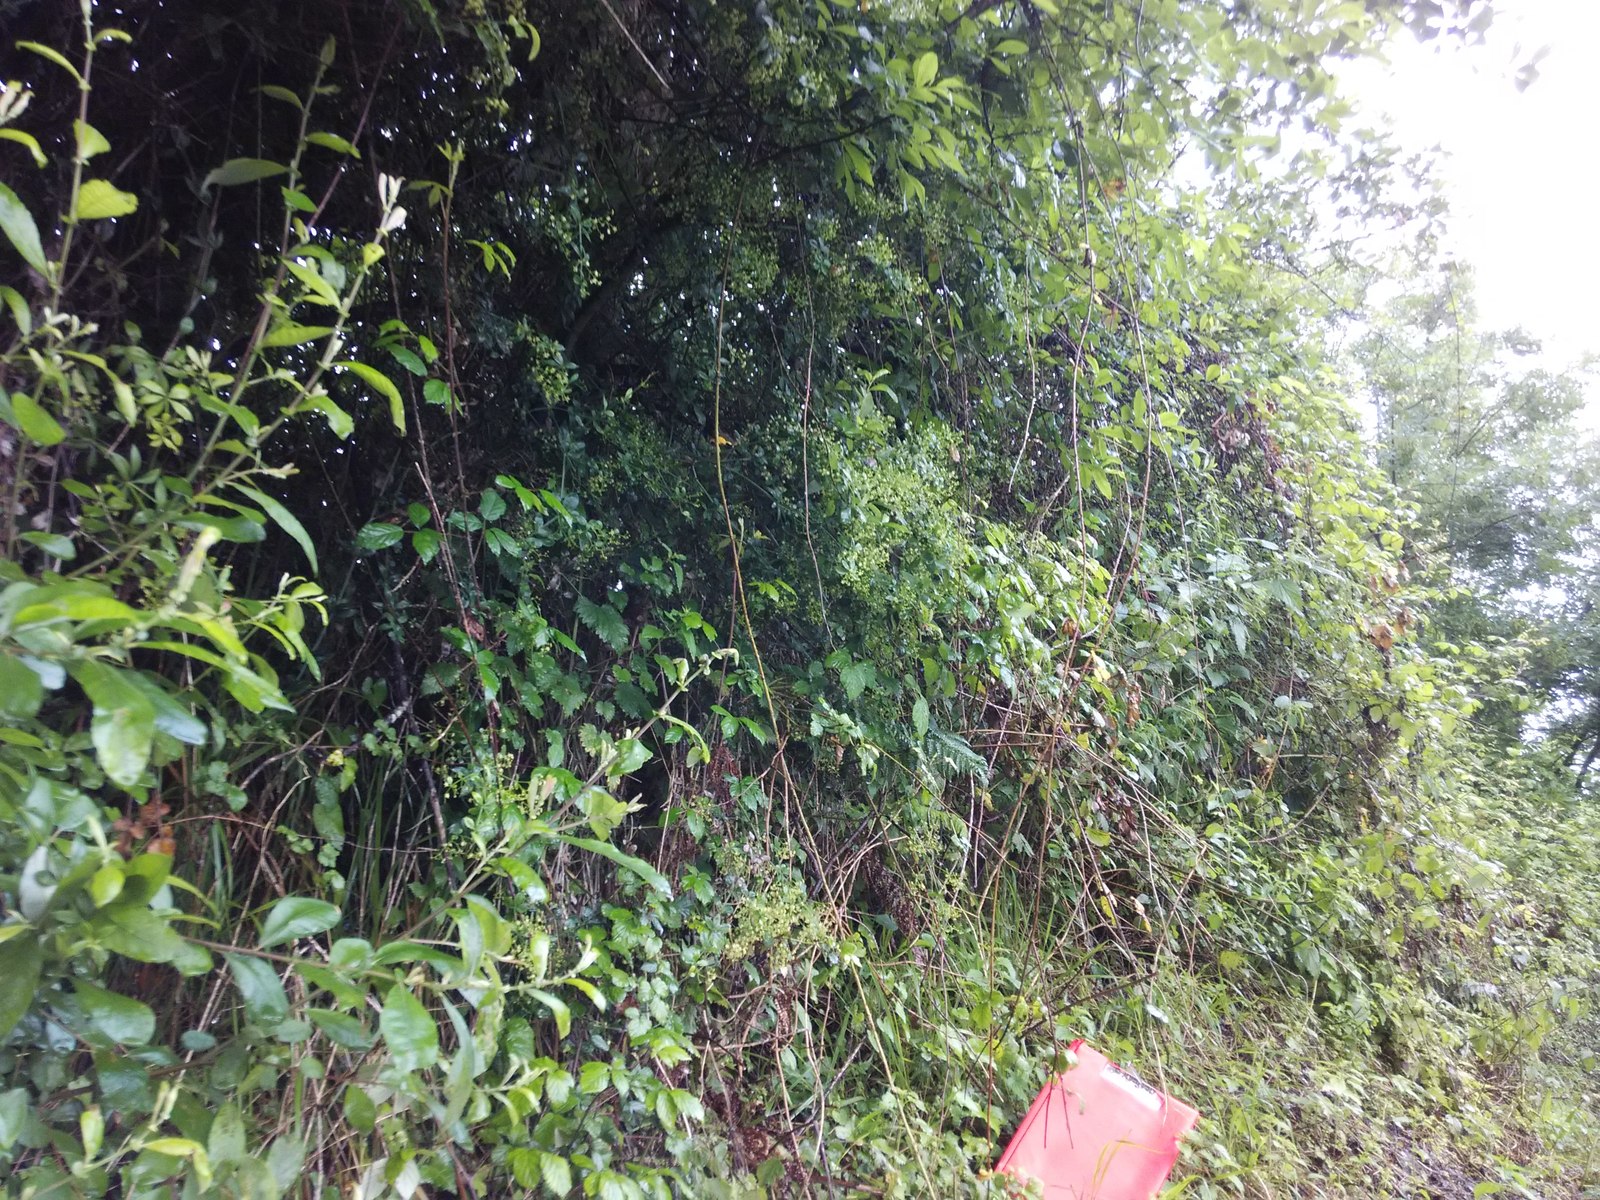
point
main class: Woodland
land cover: Broadleaved woodland
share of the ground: 25 - 50 %
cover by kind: shrubs 40 %, broadleaved forest trees 30 %, consolidated bare surface 30 %
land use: Semi-natural and natural areas not in use
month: June
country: ES
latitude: 43.2830
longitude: -2.3376
